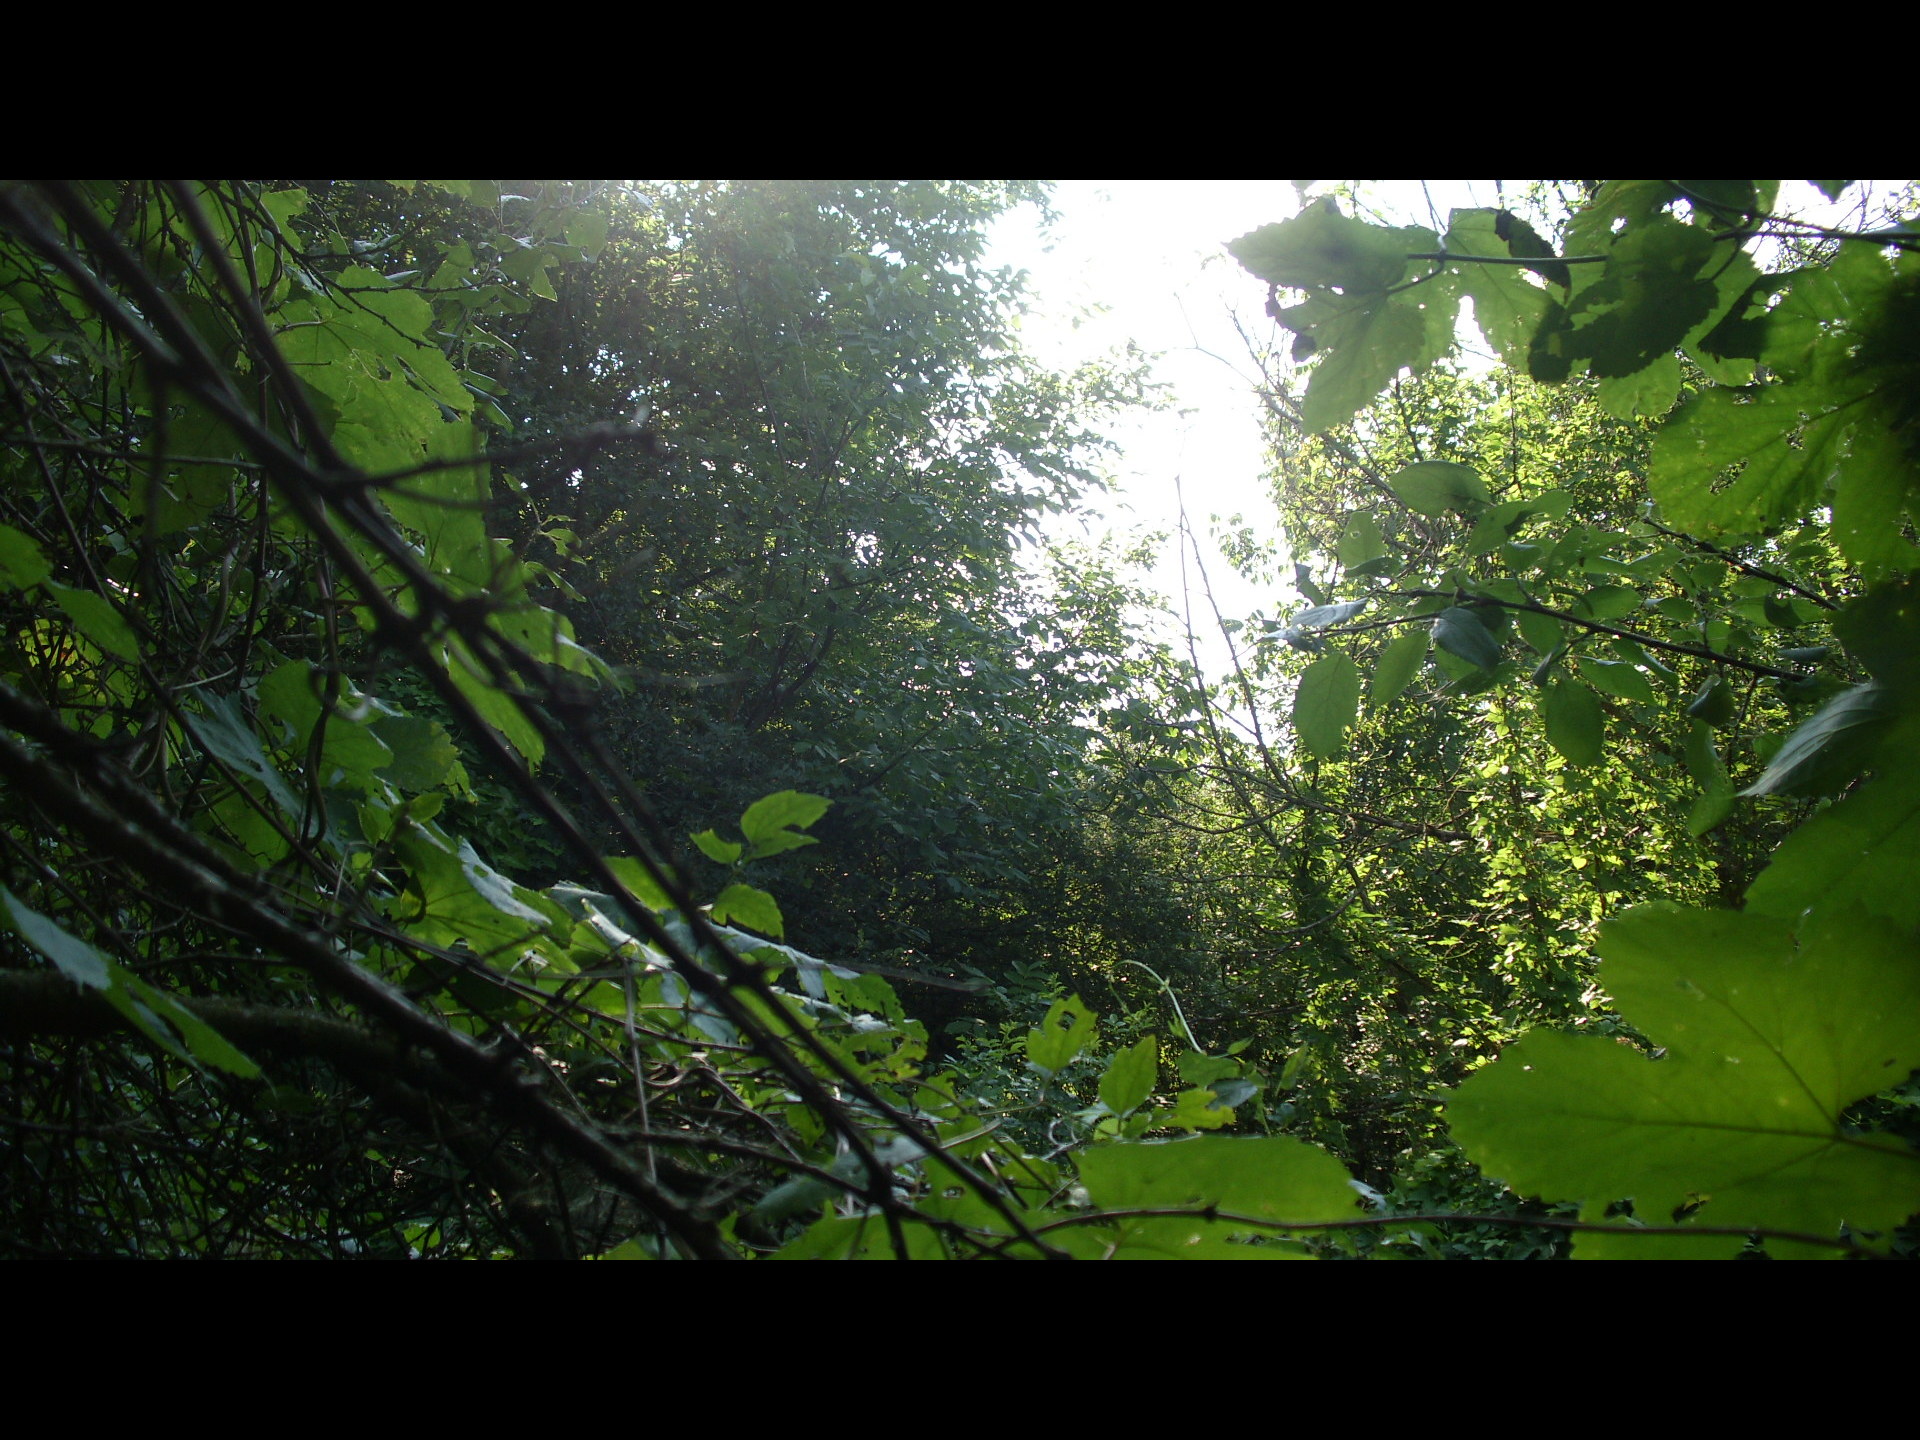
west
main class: Woodland
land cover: Broadleaved woodland
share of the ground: > 75 %
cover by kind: broadleaved forest trees 95 %, shrubs 5 %
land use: Forestry
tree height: < 5 m
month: July
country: BG
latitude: 43.7604
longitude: 23.0449
